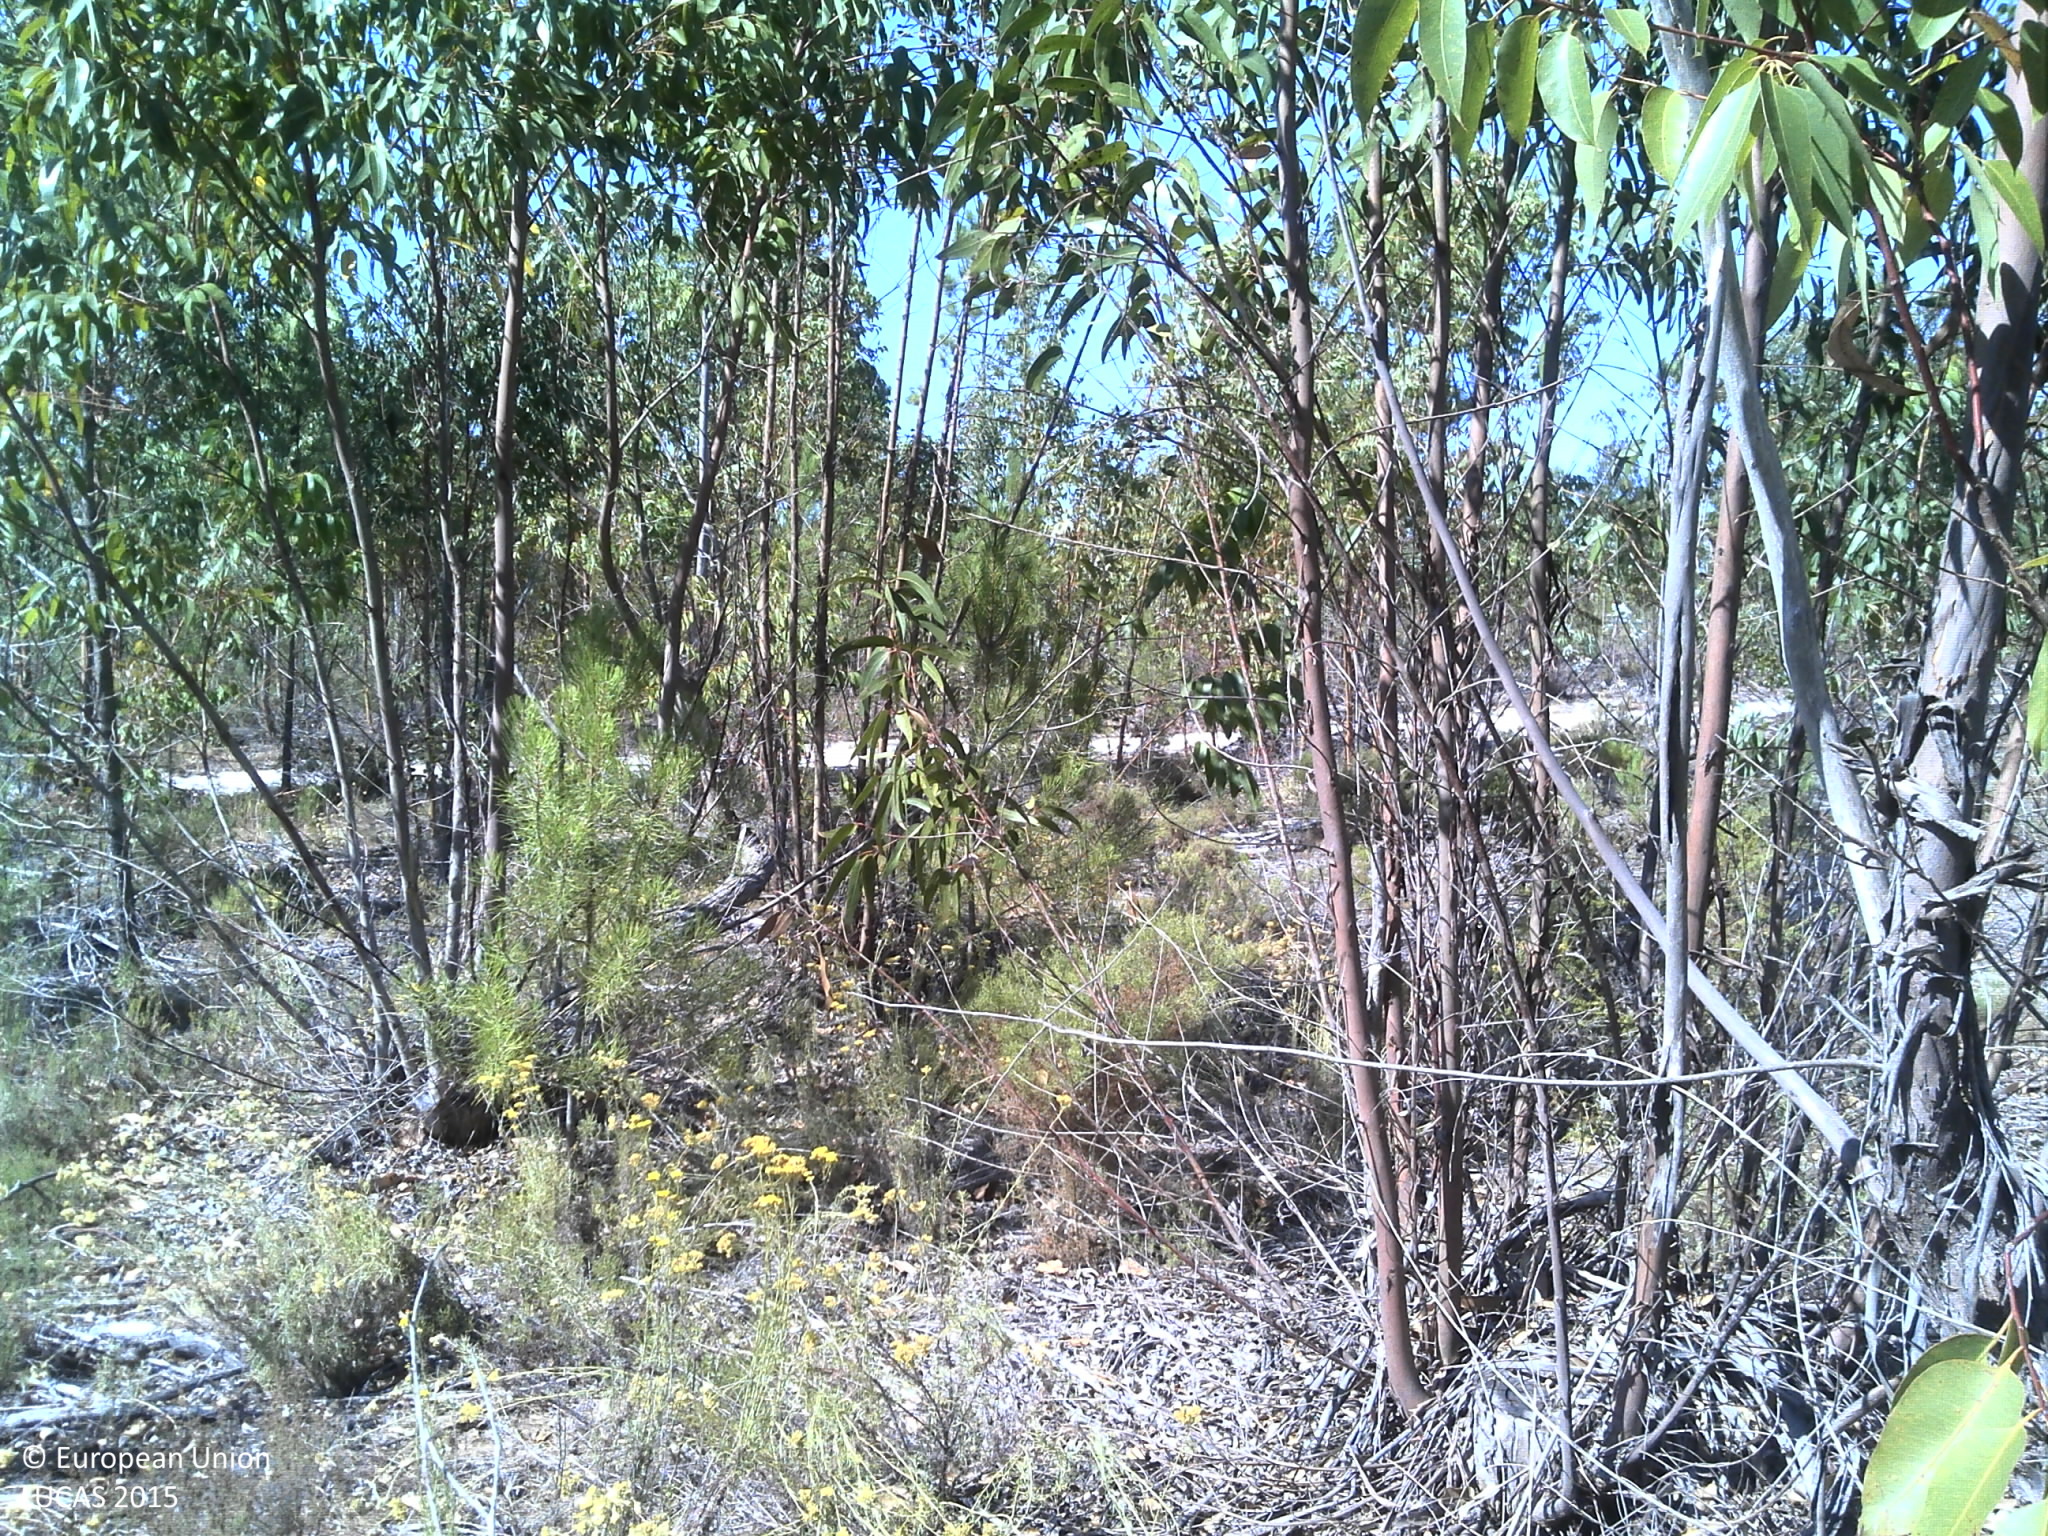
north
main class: Woodland
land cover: Broadleaved woodland
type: exotic forest
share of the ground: 25 - 50 %
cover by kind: broadleaved forest trees 40 %, unconsolidated bare surface 35 %, shrubs 10 %, herbaceous plants 10 %, coniferous forest trees 5 %
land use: Forestry
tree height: > 5 m
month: July
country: PT
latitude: 38.3108
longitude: -8.6607
